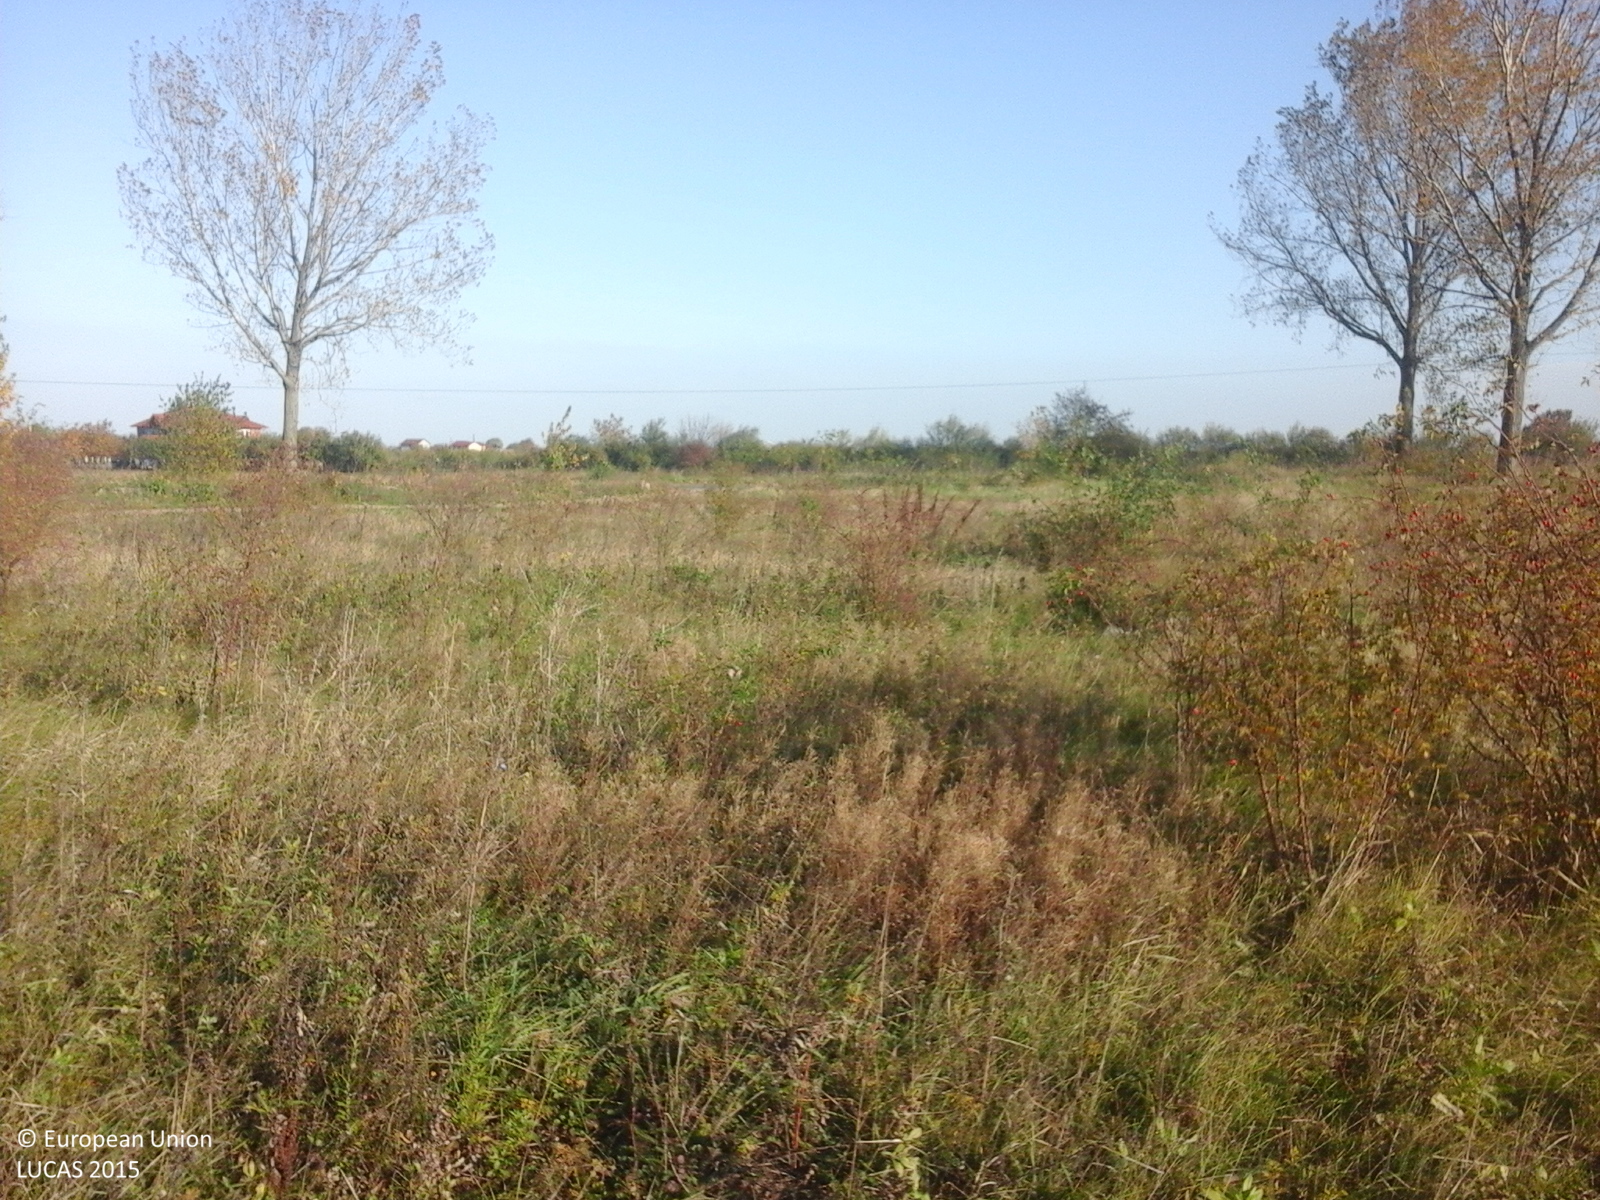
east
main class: Grassland
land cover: Spontaneously vegetated surfaces
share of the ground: > 75 %
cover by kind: herbaceous plants 100 %
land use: Fallow land
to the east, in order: Spontaneously vegetated surfaces; Tracks; Spontaneously vegetated surfaces; Electric lines; Paved roads, cycling and walking lanes; Grass margins; Ditches and canals; Spontaneously vegetated surfaces; Lucerne; Grassland without tree/shrub cover; Fences; Lines of trees; Tracks; Fences; Lines of trees; Spontaneously vegetated surfaces; Other bare soil; Lines of trees; Spontaneously vegetated surfaces
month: October
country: RO
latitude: 45.8301
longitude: 27.0723
